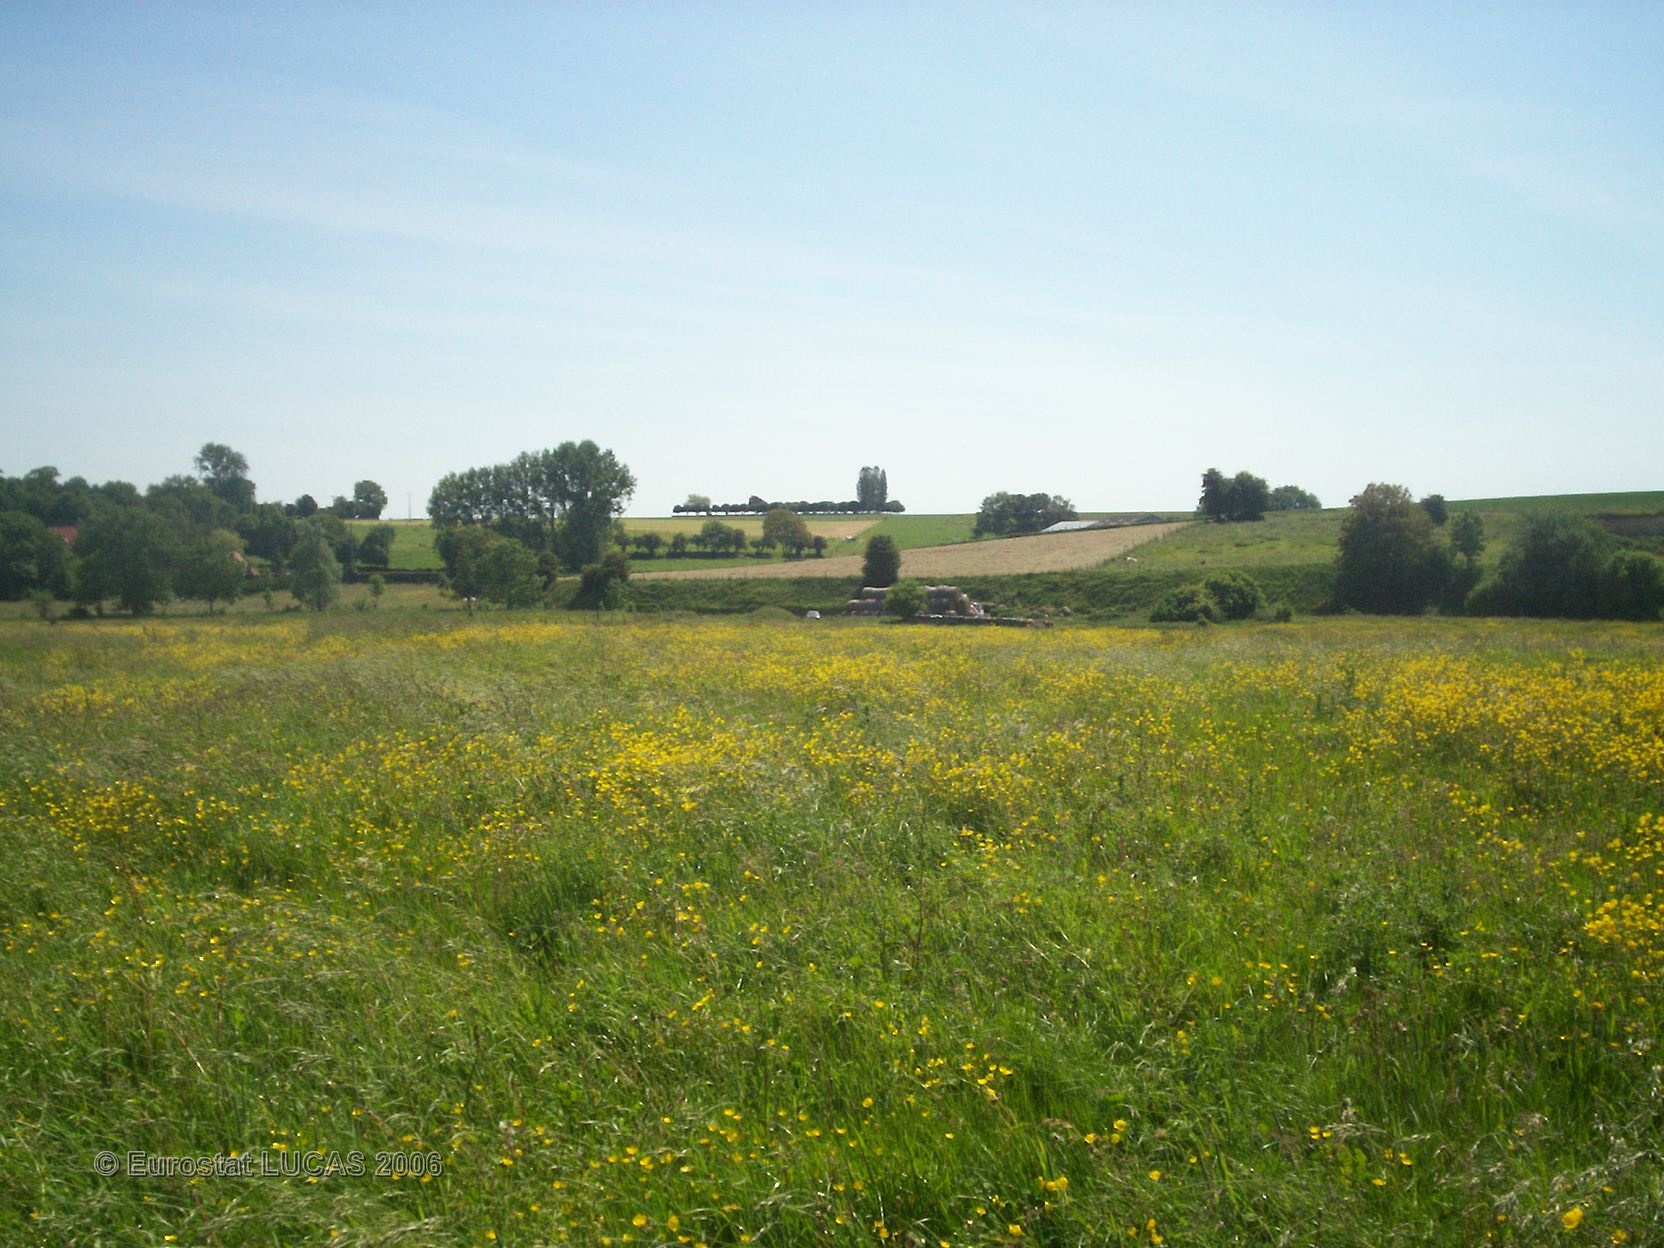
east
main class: Grassland
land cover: Grassland without tree/shrub cover
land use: Agriculture (excluding fallow land and kitchen gardens)
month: June
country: FR
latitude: 50.2468
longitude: 2.5413
